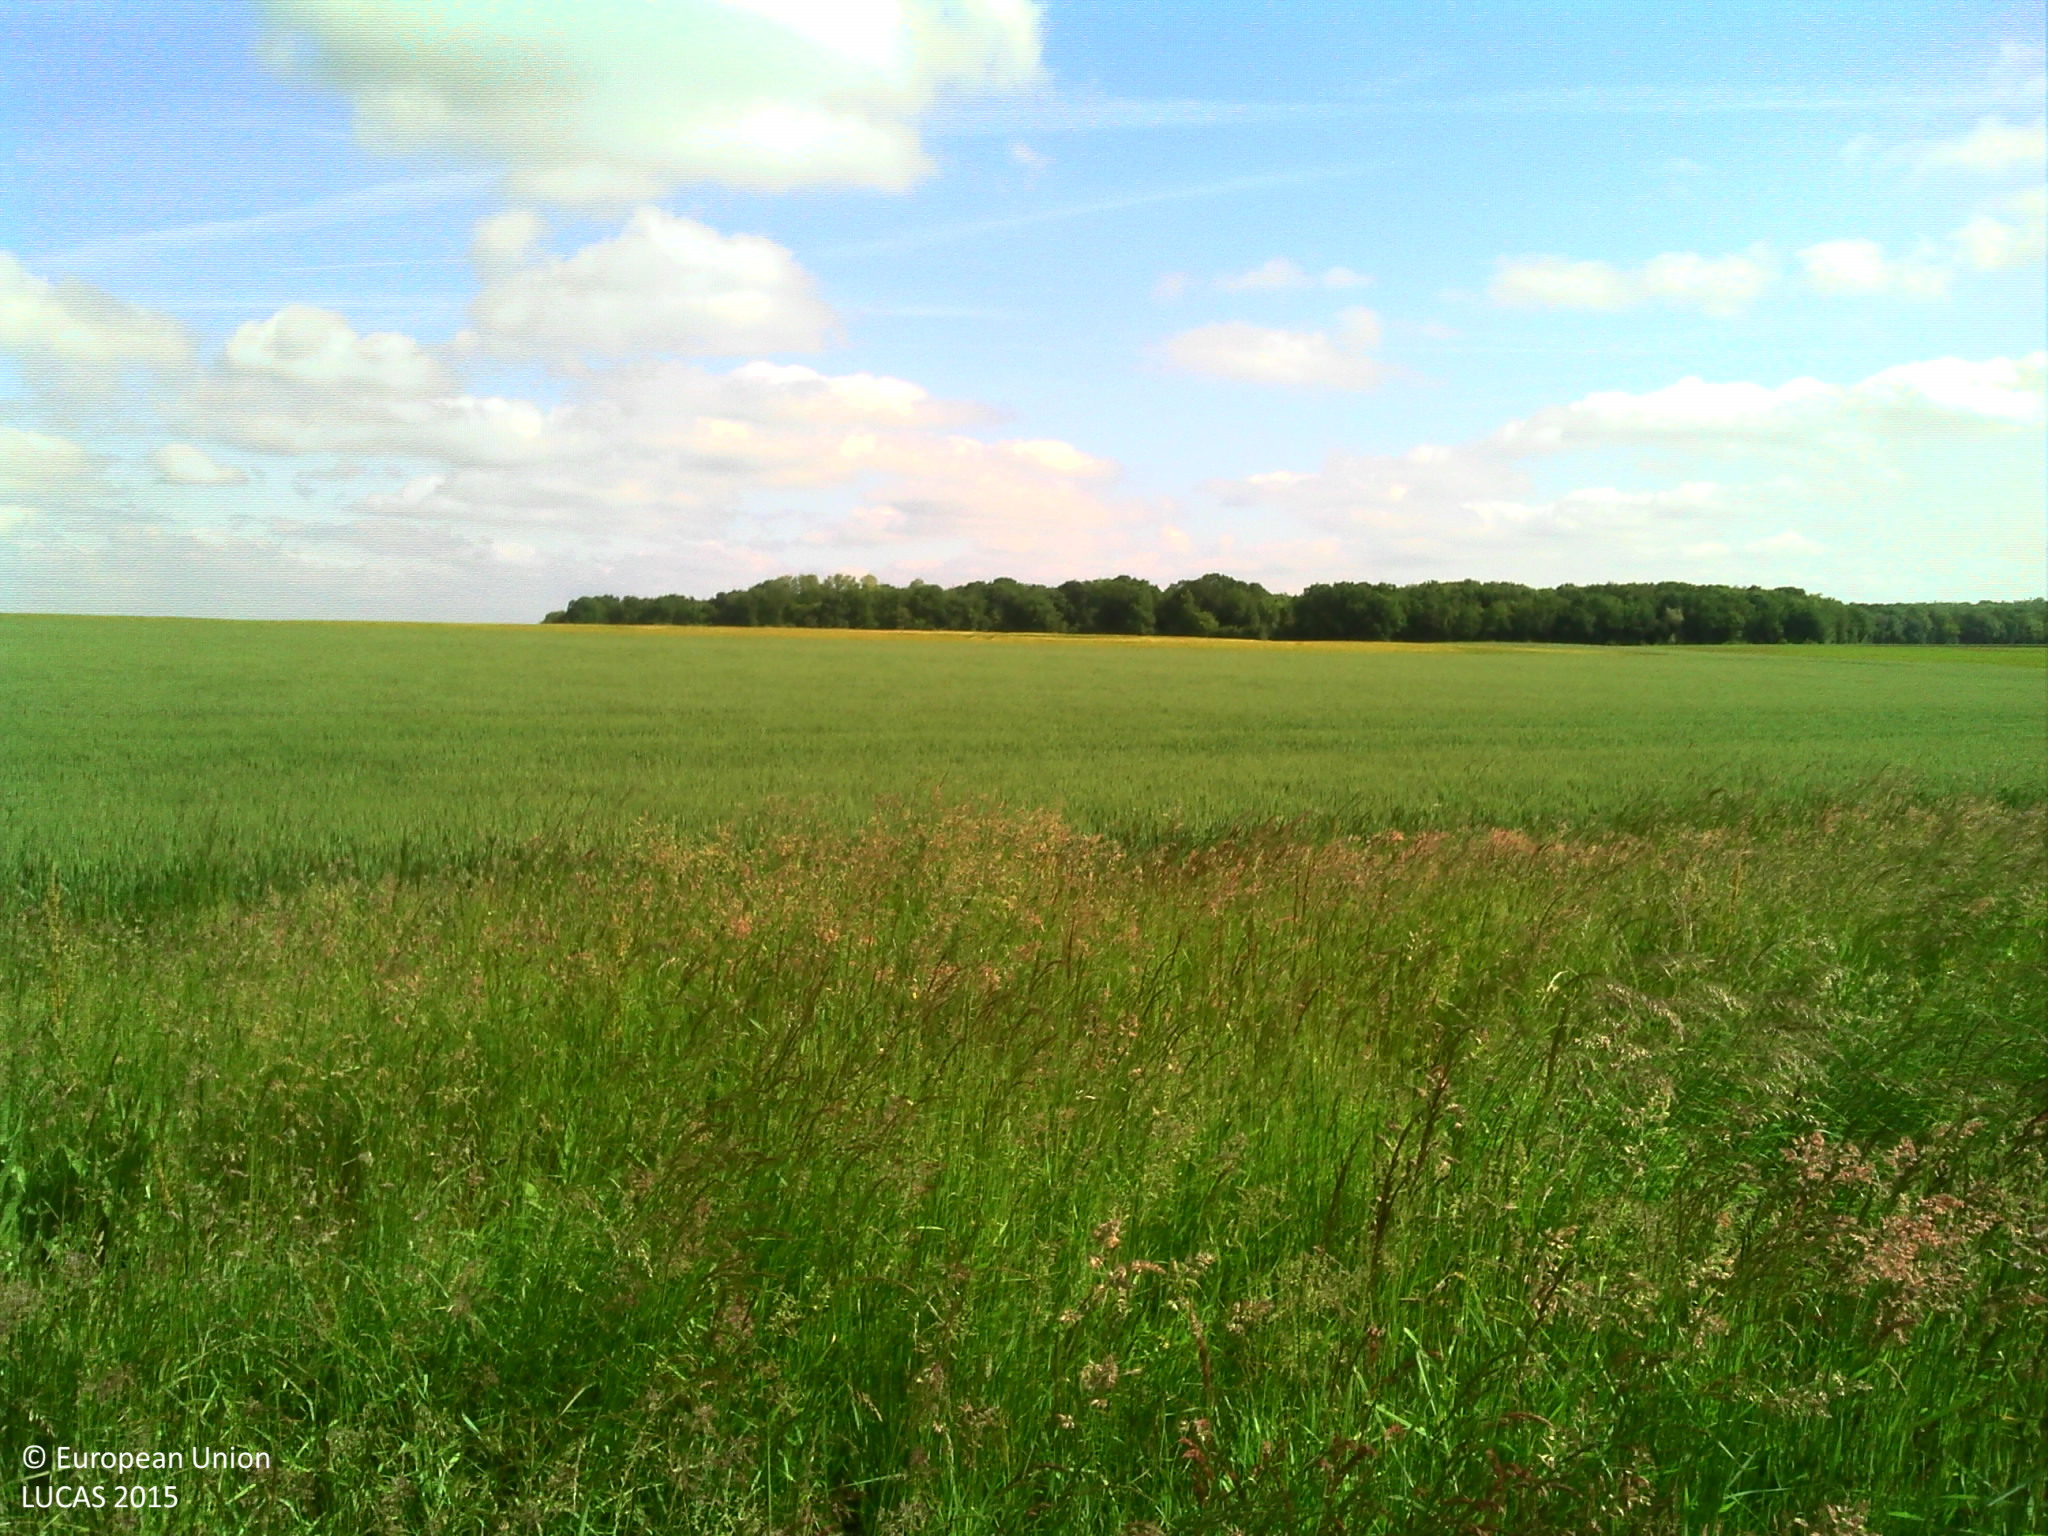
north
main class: Cropland
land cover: Common wheat
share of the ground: > 75 %
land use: Agriculture (excluding fallow land and kitchen gardens)
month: May
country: FR
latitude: 47.4346
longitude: 5.2141
